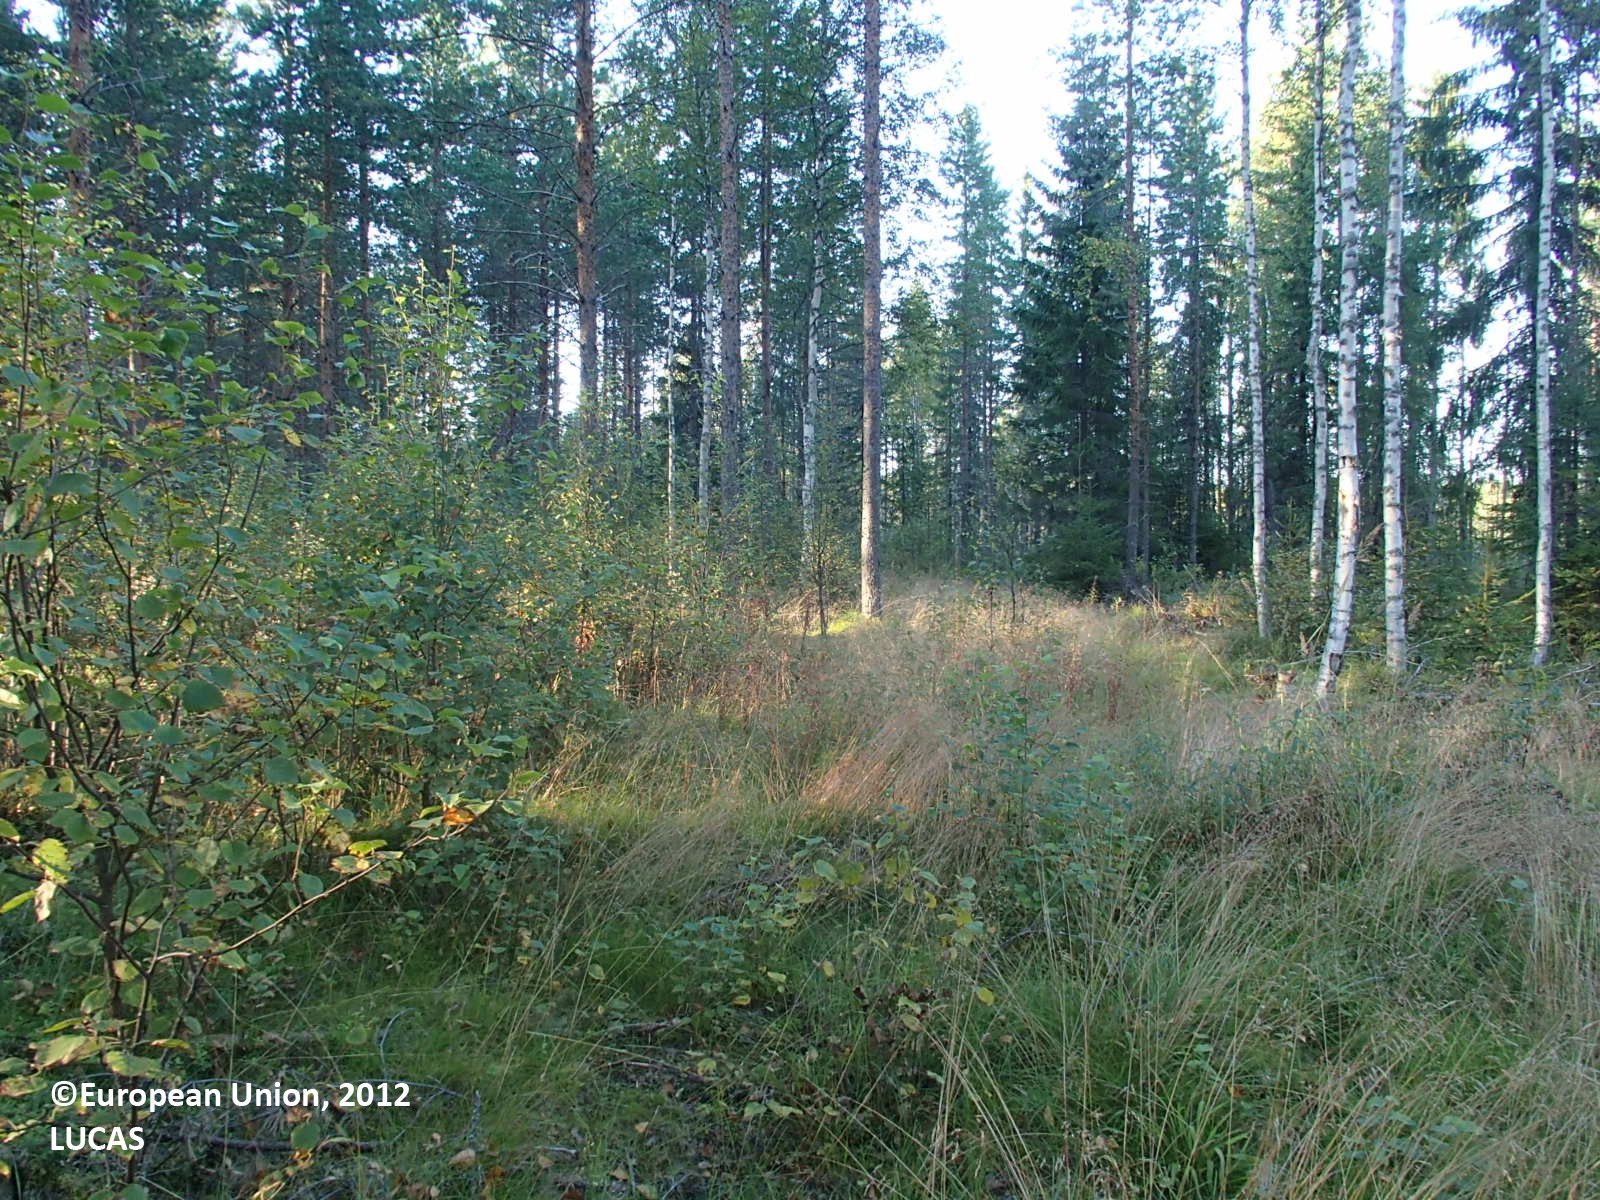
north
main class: Woodland
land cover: Pine dominated mixed woodland
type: boreal forest
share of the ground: 50 - 75 %
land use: Forestry
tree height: > 5 m
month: August
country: FI
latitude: 63.4999
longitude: 28.0311
